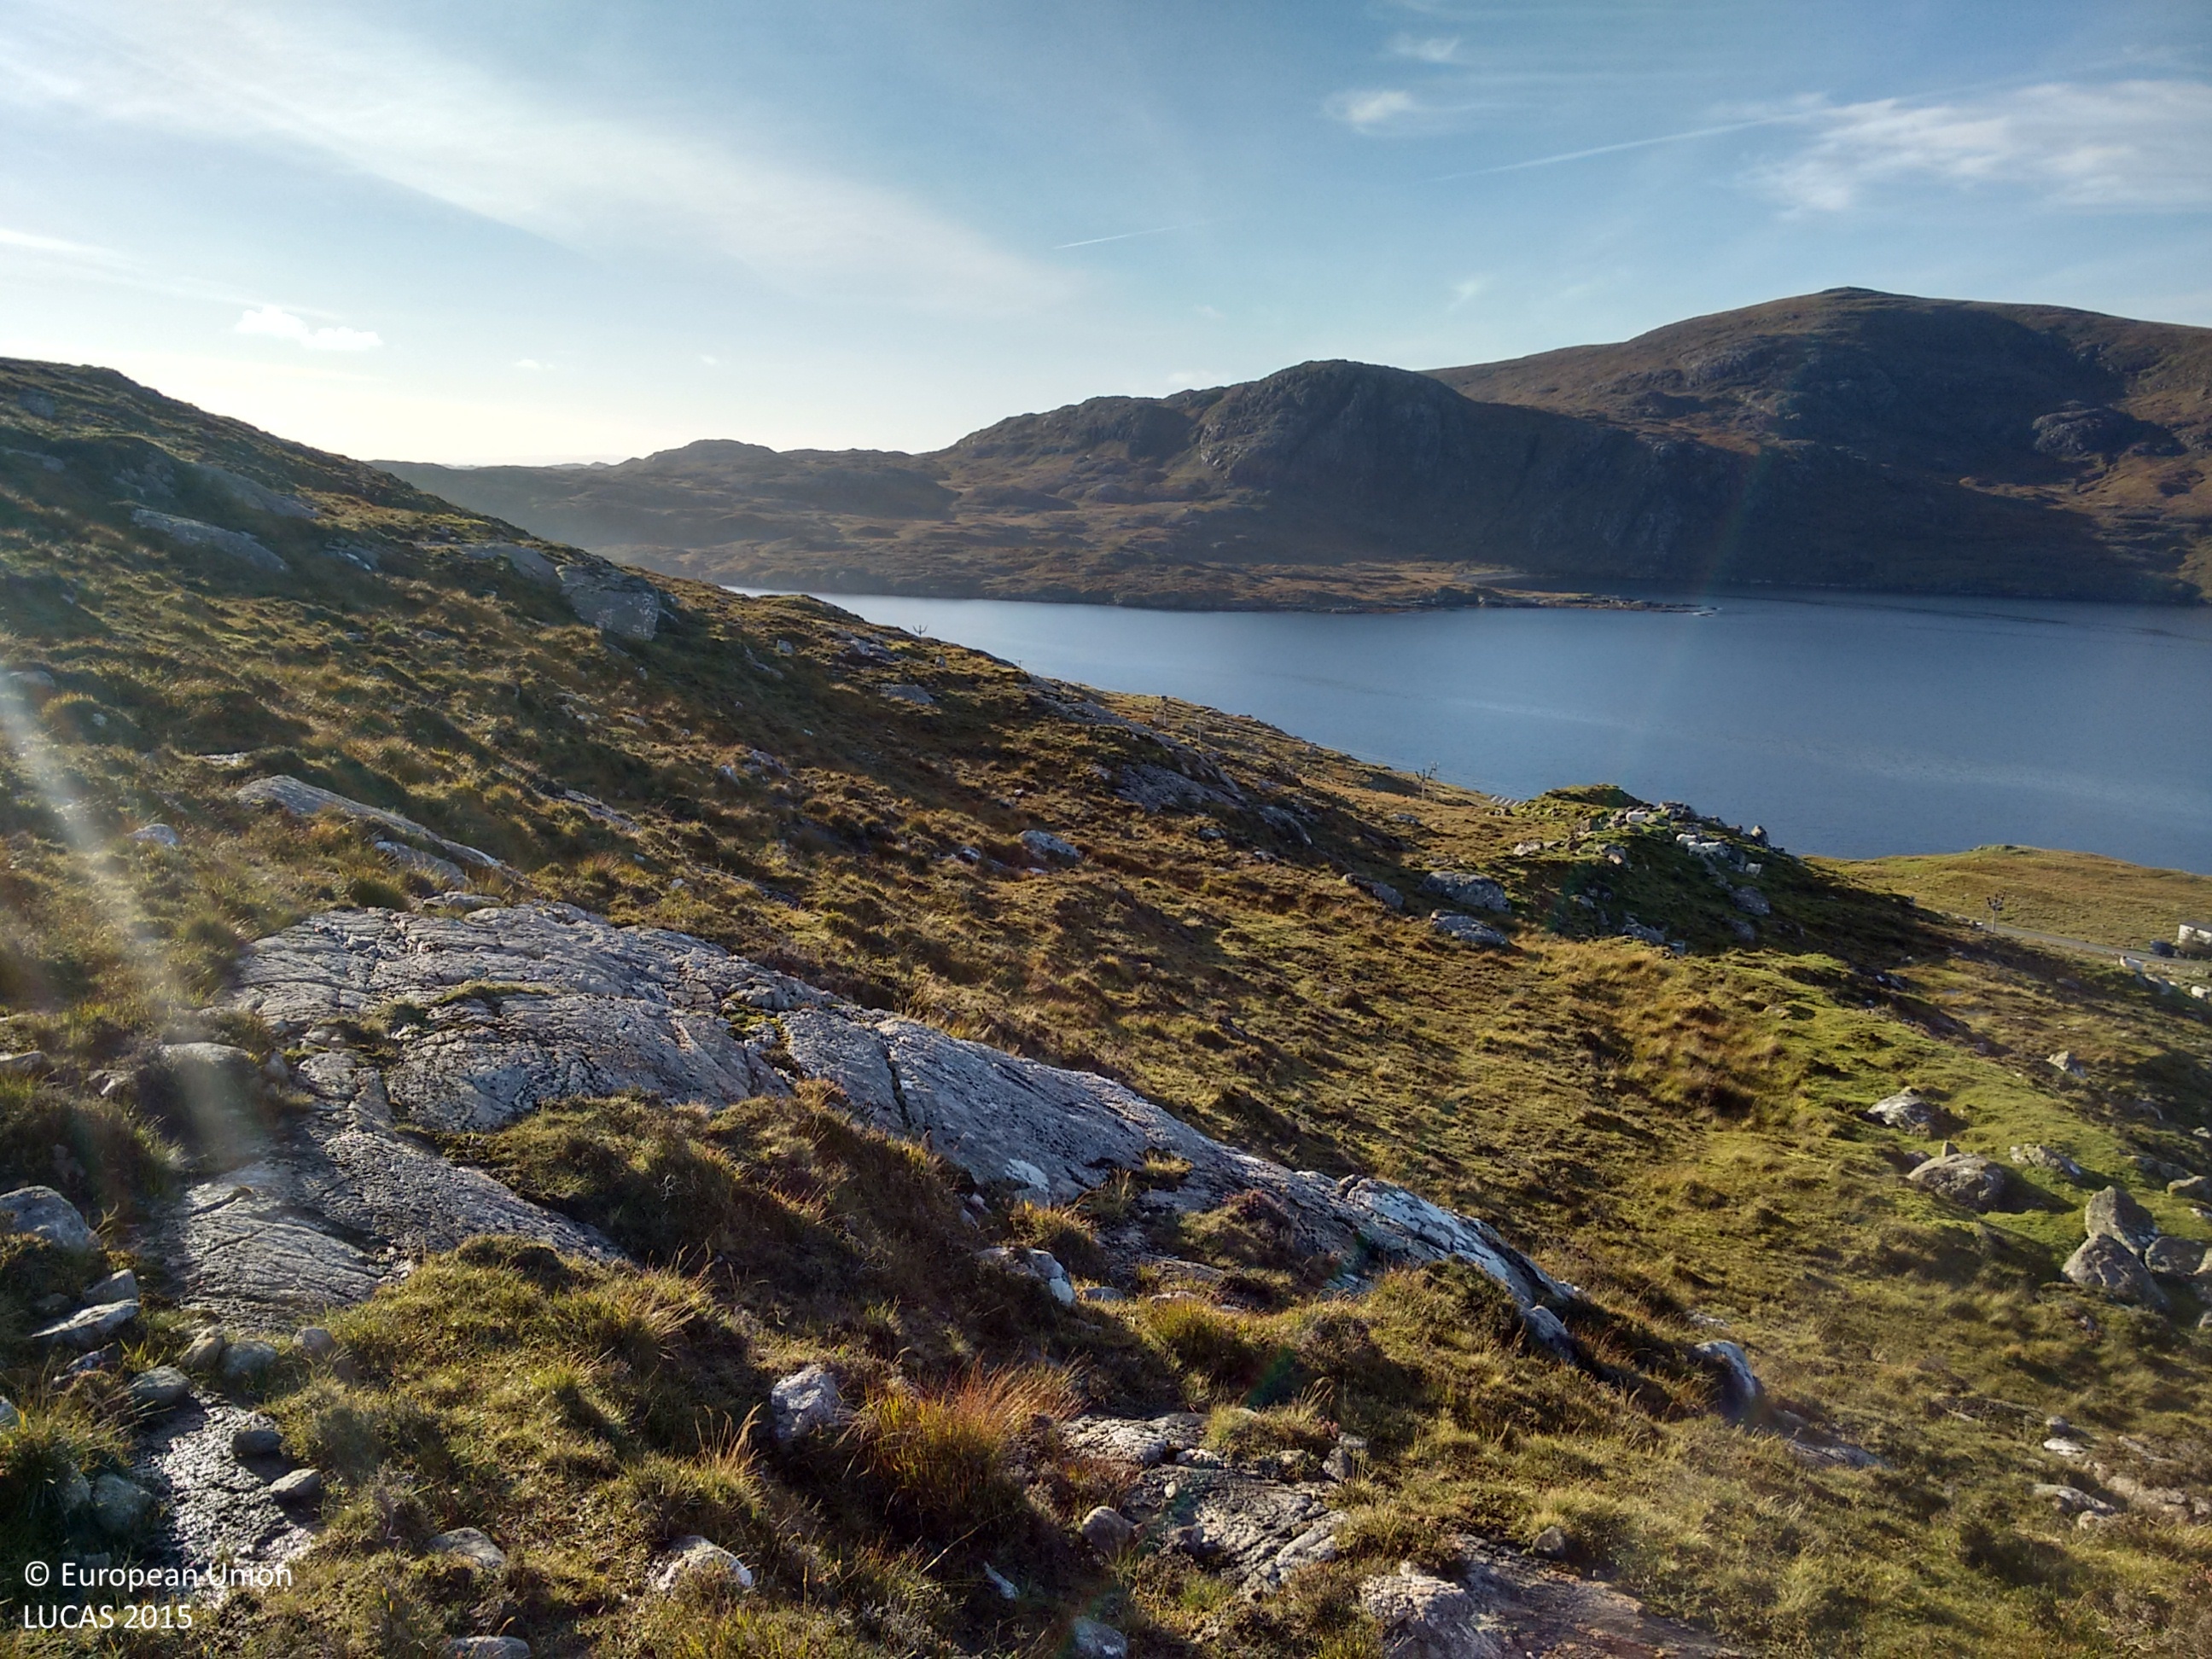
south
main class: Shrubland
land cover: Shrubland without tree cover
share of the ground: 25 - 50 %
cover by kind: herbaceous plants 40 %, shrubs 30 %
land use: Agriculture (excluding fallow land and kitchen gardens)
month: October
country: GB
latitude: 57.9187
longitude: -6.8457
